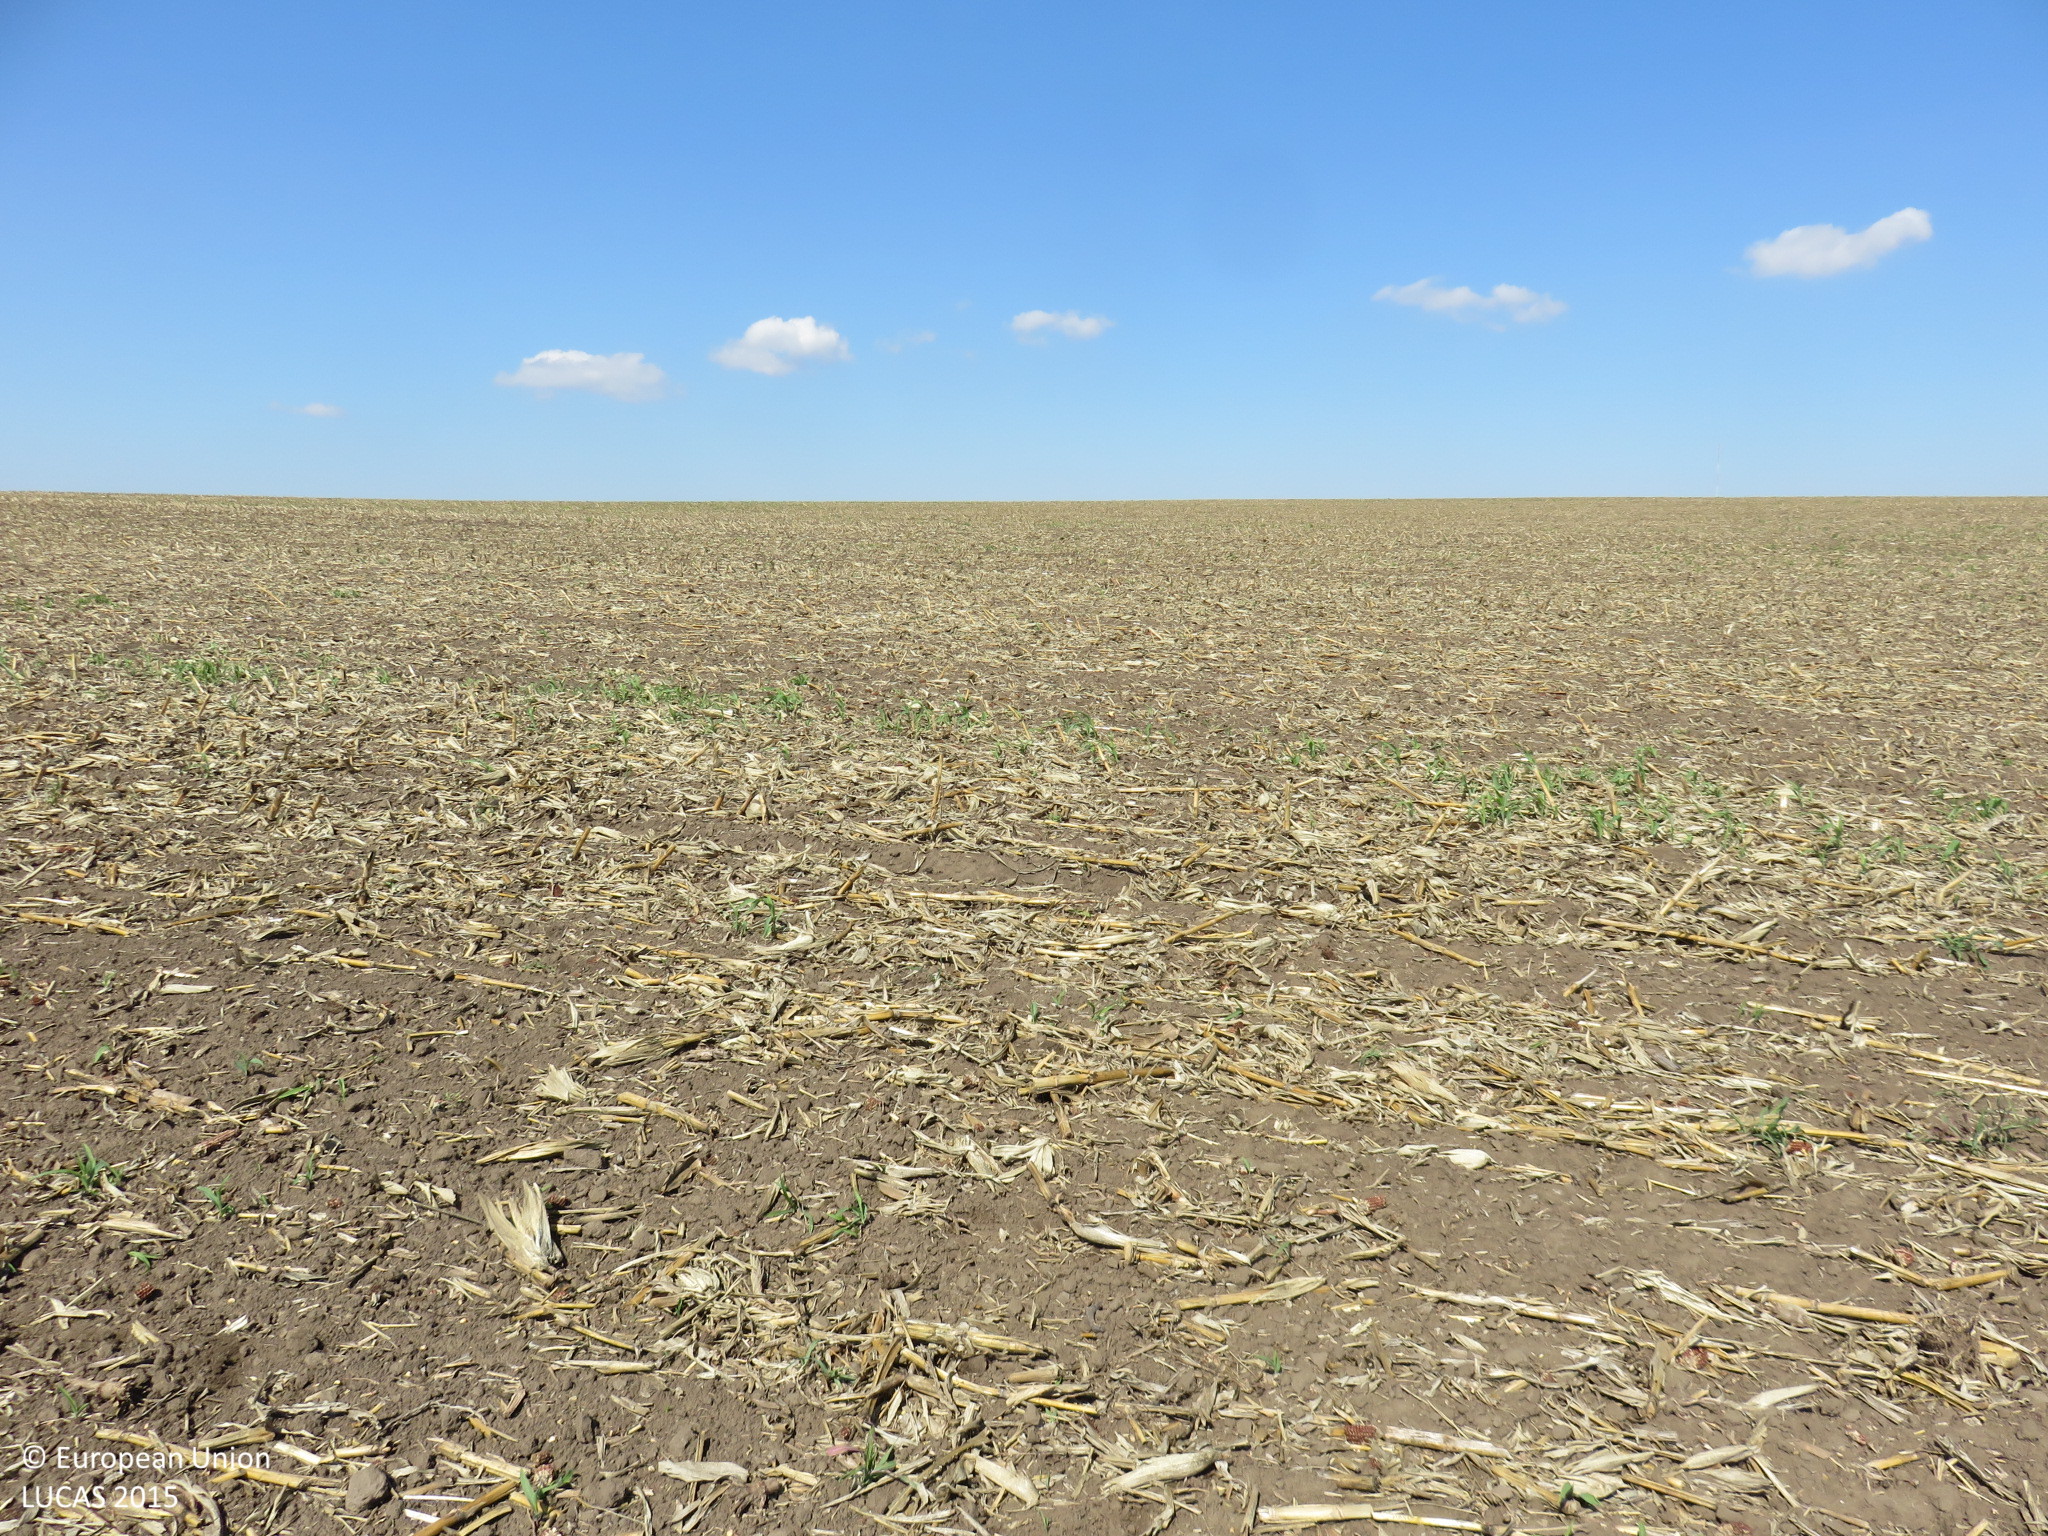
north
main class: Cropland
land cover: Maize
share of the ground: > 75 %
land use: Agriculture (excluding fallow land and kitchen gardens)
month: September
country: BG
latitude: 43.6187
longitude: 24.4992
